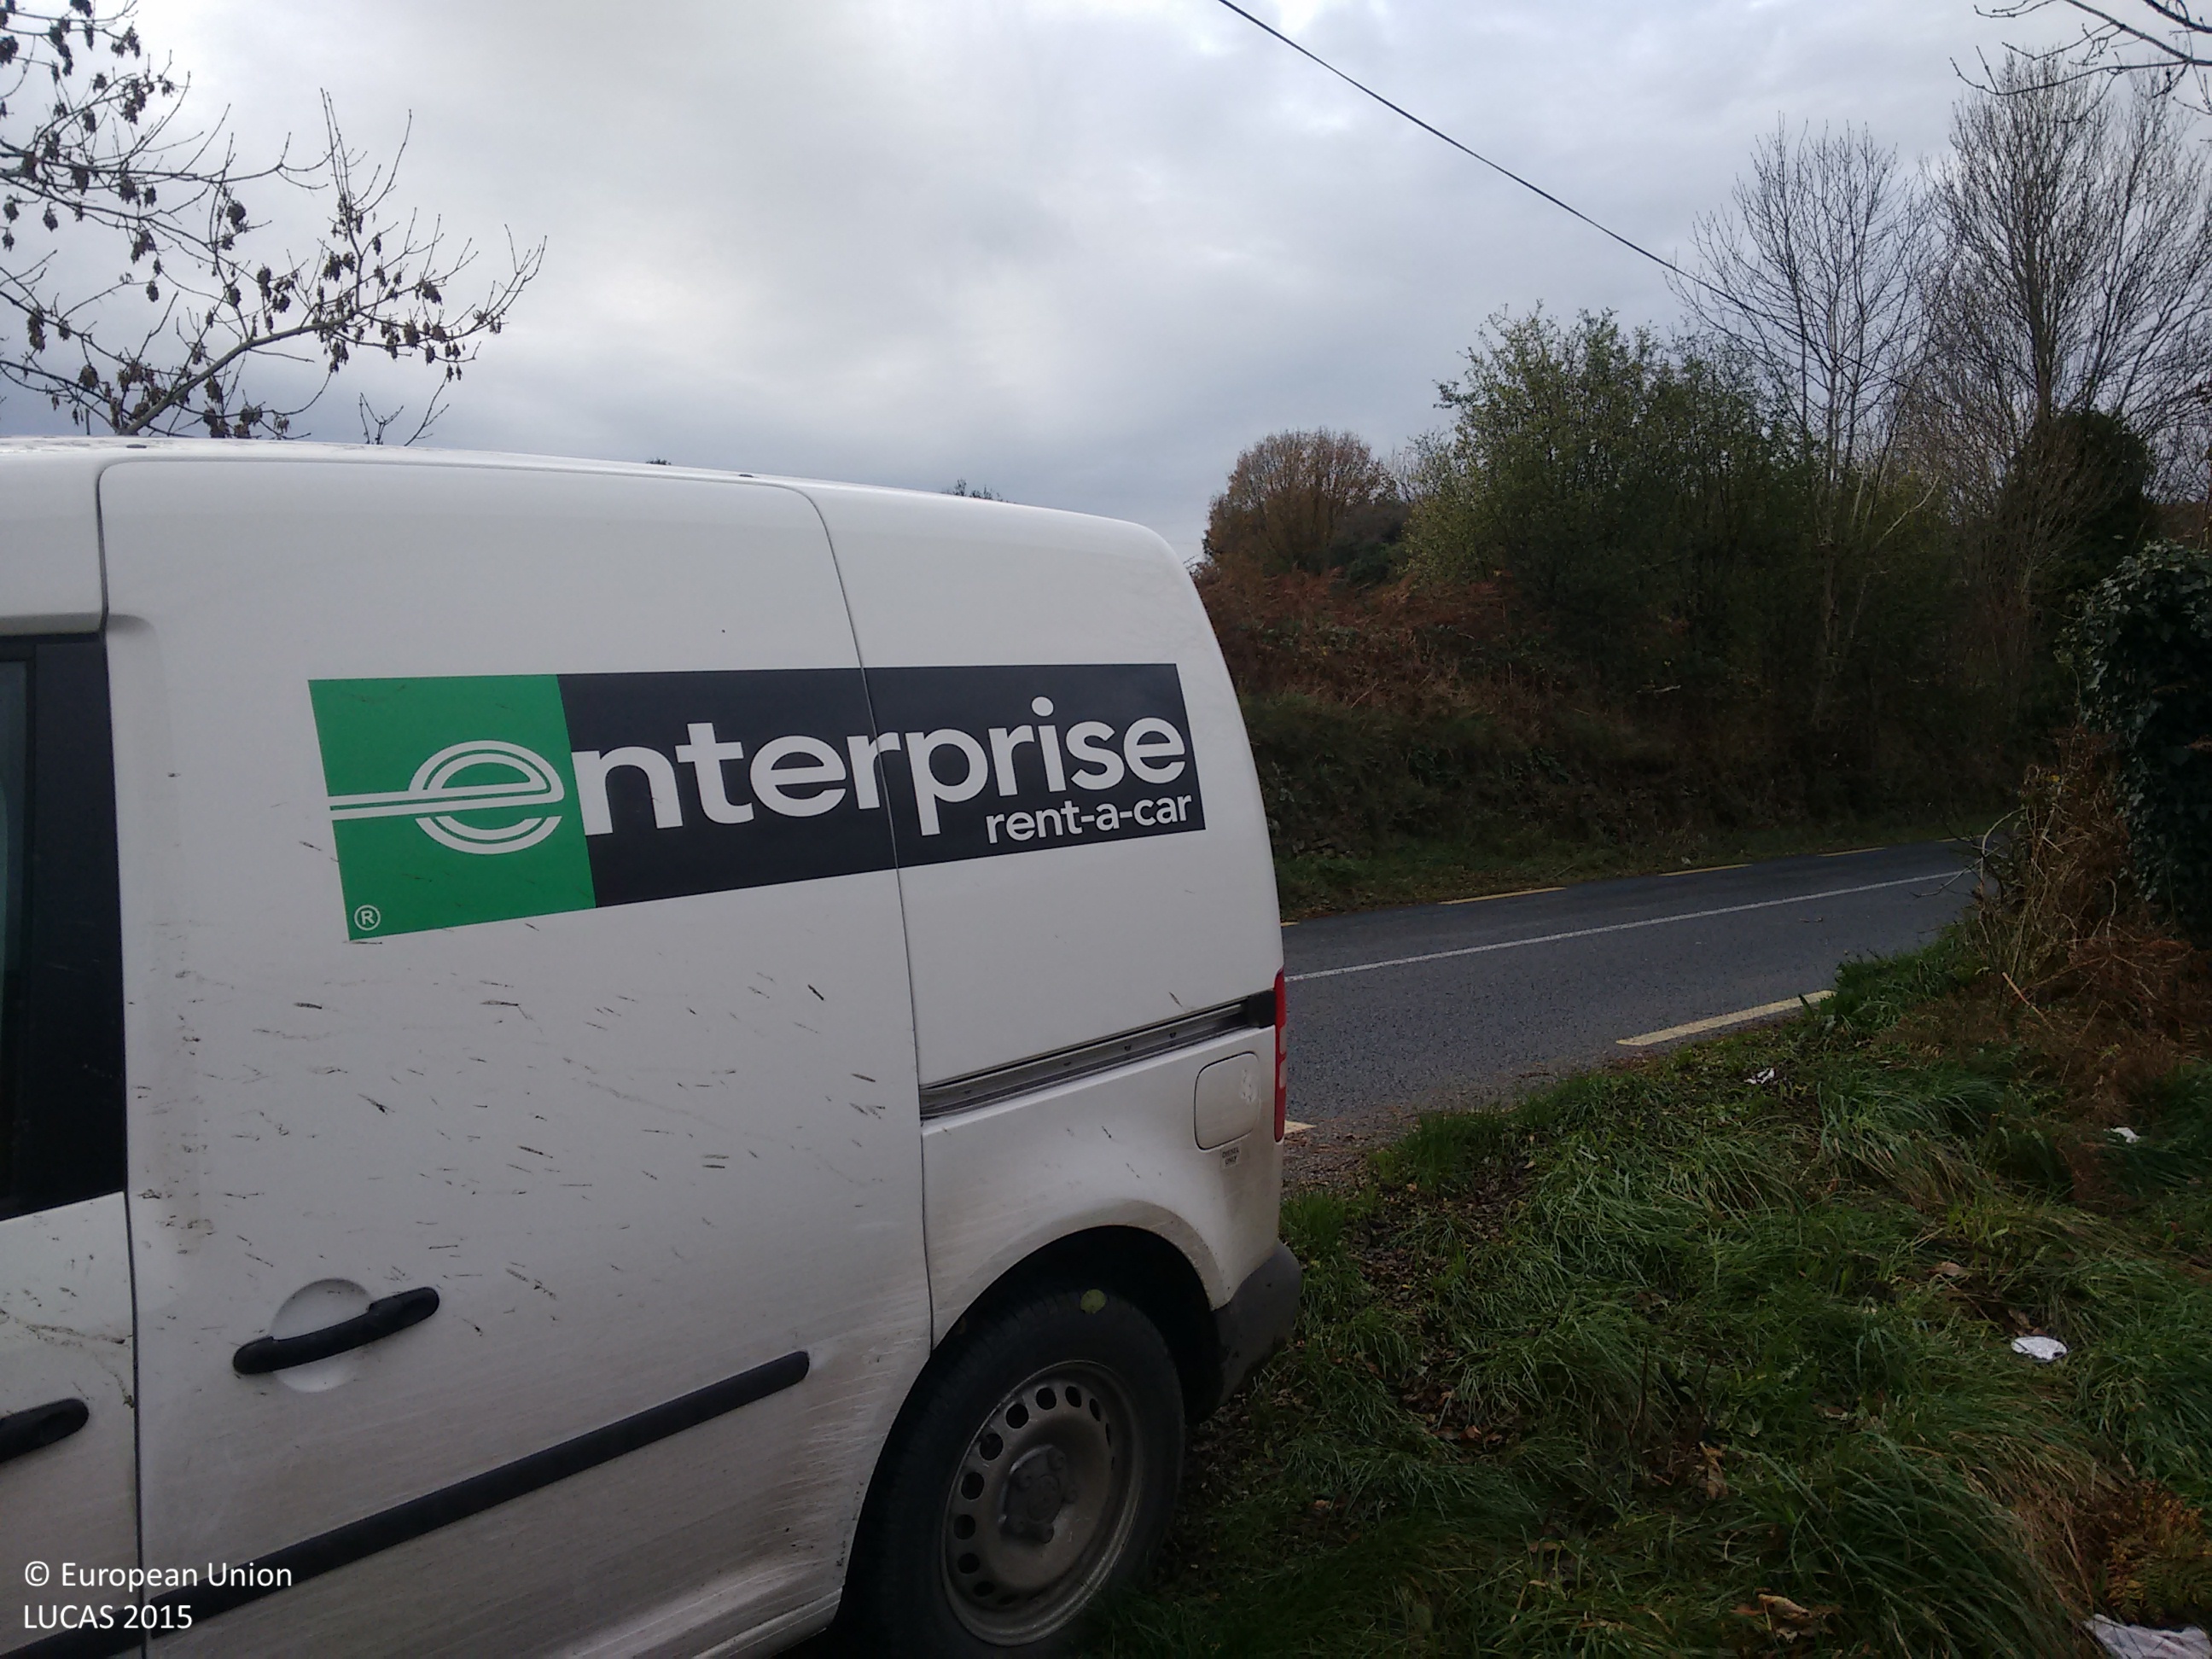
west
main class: Cropland
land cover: Temporary grasslands
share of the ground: > 75 %
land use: Agriculture (excluding fallow land and kitchen gardens)
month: November
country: IE
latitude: 52.8996
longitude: -6.2499
